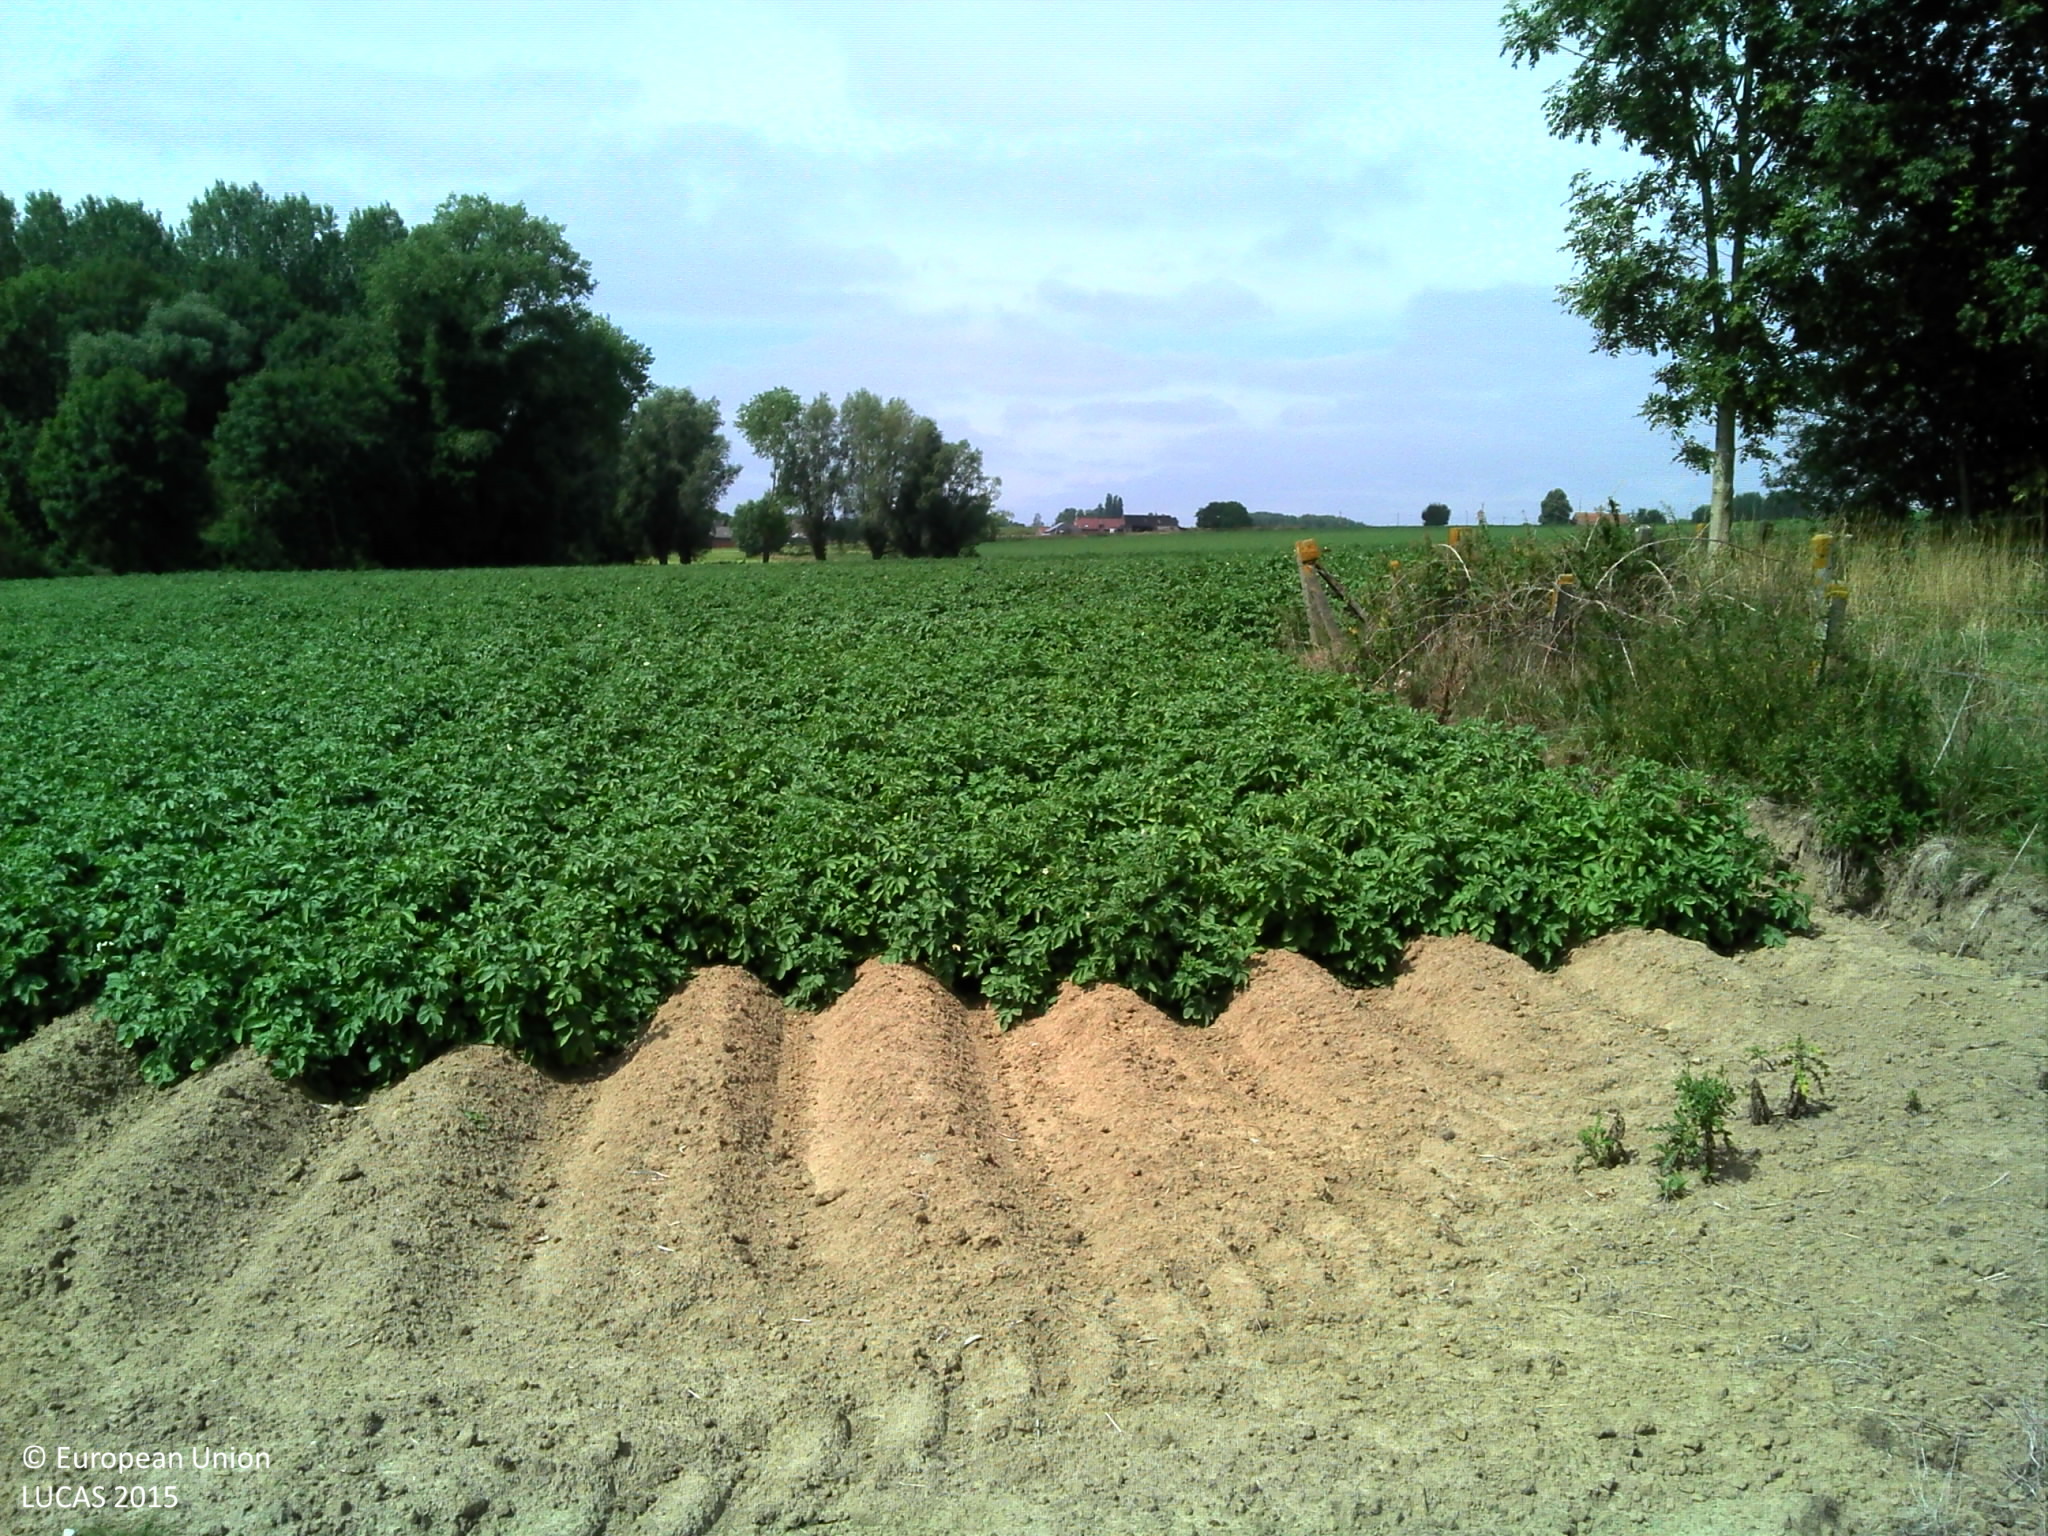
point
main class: Cropland
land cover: Potatoes
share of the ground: > 75 %
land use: Agriculture (excluding fallow land and kitchen gardens)
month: August
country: BE
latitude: 50.7370
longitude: 3.8013
